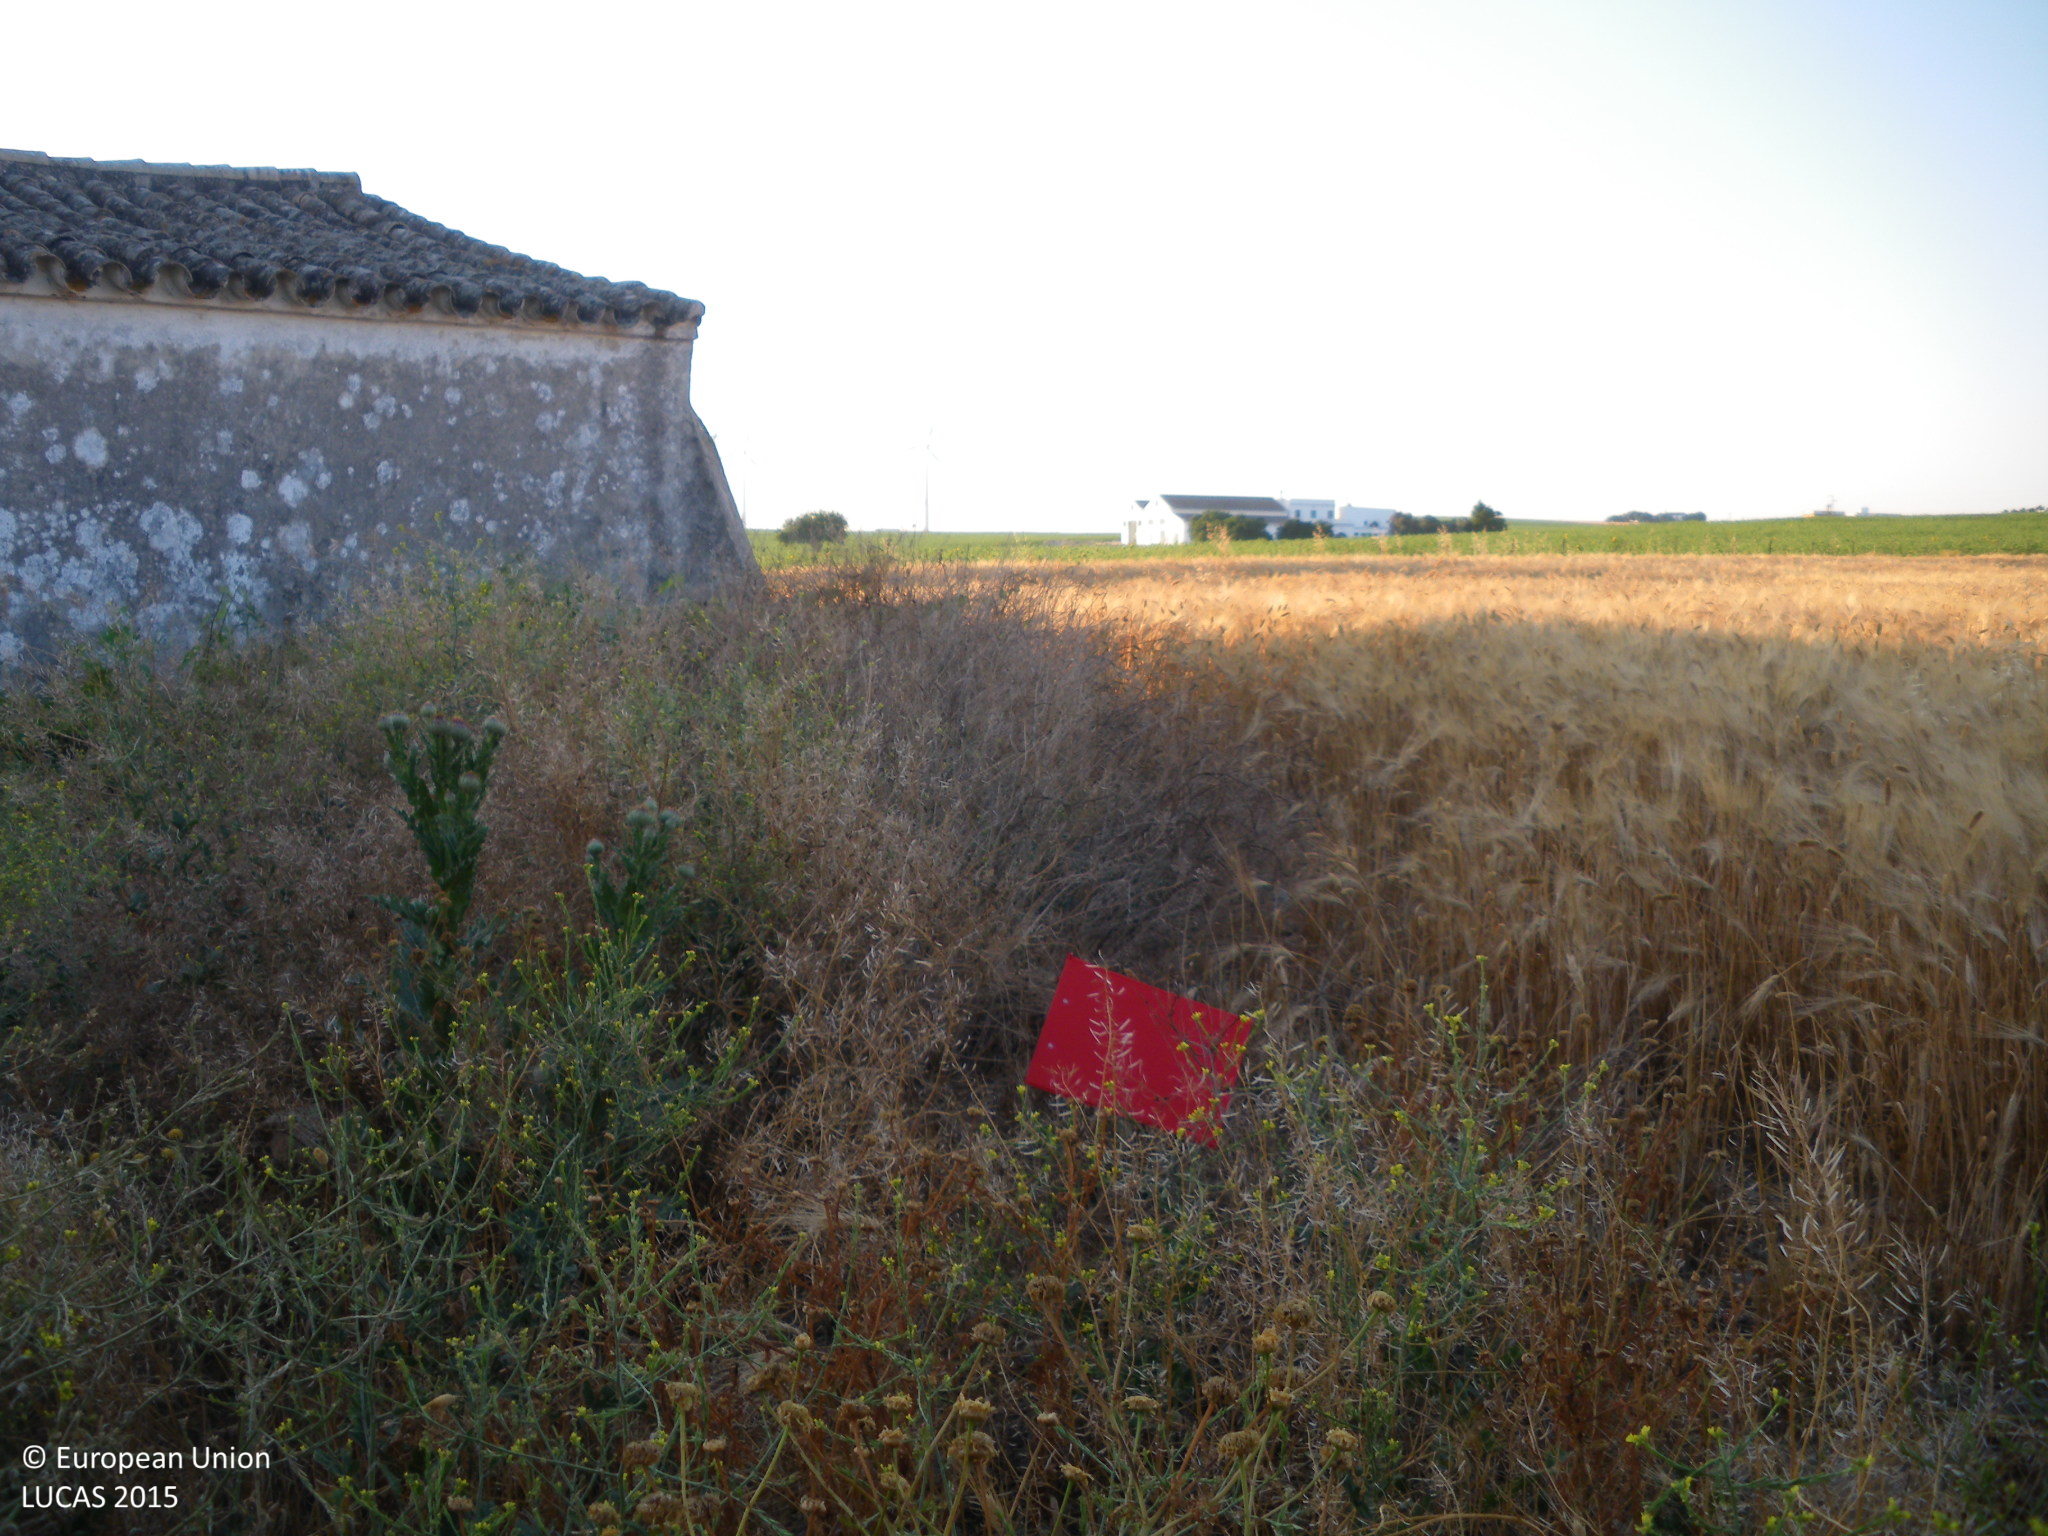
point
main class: Grassland
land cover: Grassland without tree/shrub cover
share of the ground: > 75 %
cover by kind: herbaceous plants 95 %, unconsolidated bare surface 5 %
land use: Semi-natural and natural areas not in use
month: May
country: ES
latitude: 36.6897
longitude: -6.2534
